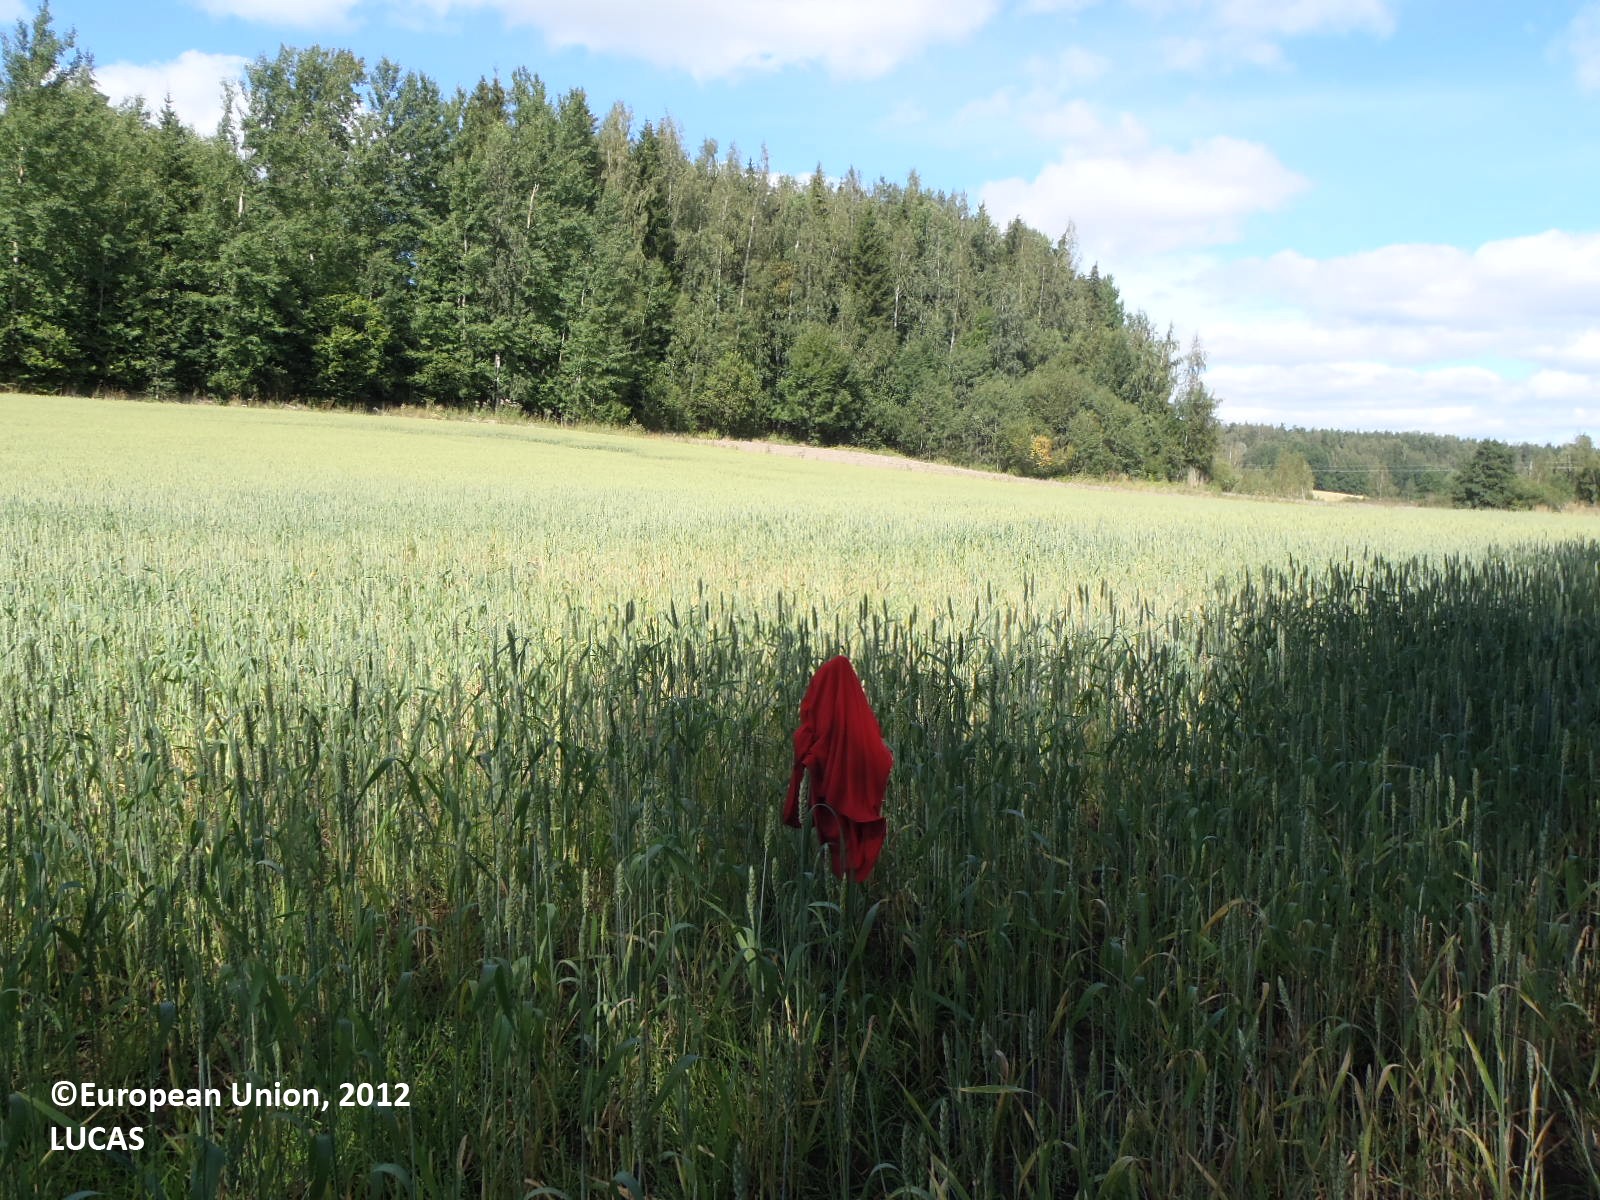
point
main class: Cropland
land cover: Common wheat
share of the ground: > 75 %
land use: Agriculture (excluding fallow land and kitchen gardens)
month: August
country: FI
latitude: 60.3423
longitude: 22.4079
